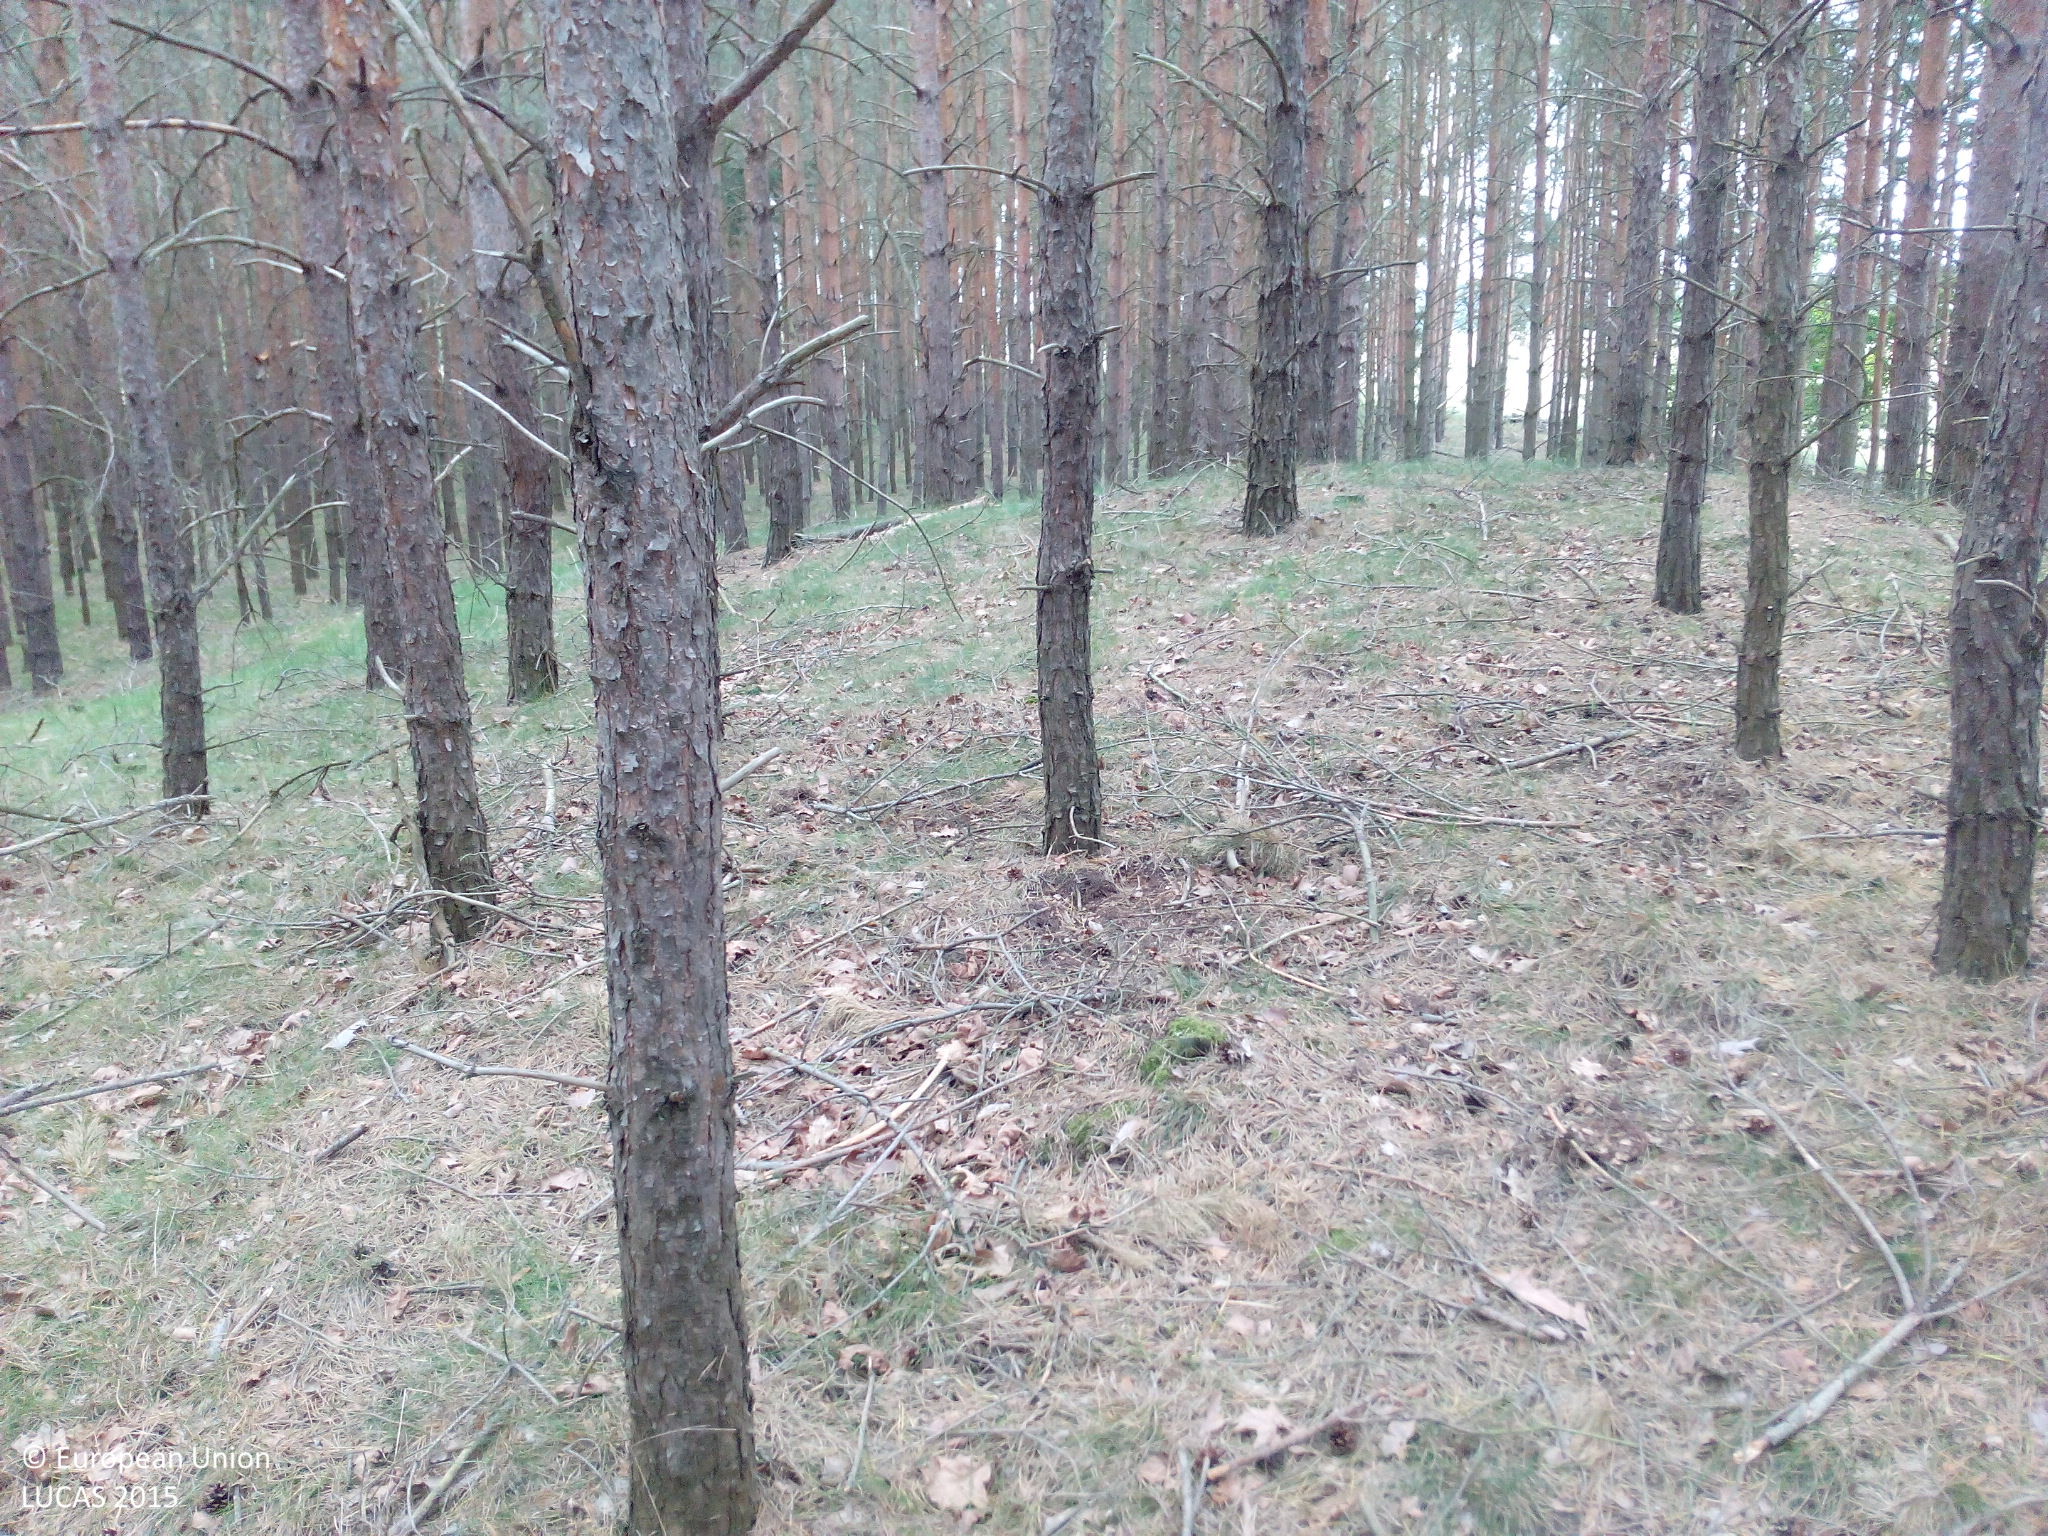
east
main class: Woodland
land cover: Pine dominated coniferous woodland
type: hemiboreal forest and nemoral coniferous forest and mixed broadleaved-coniferous forest
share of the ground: > 75 %
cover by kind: coniferous forest trees 80 %, herbaceous plants 10 %, unconsolidated bare surface 10 %
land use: Forestry
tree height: > 5 m
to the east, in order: Pine dominated coniferous woodland; Maize
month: May
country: DE
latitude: 52.1919
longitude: 13.1451
